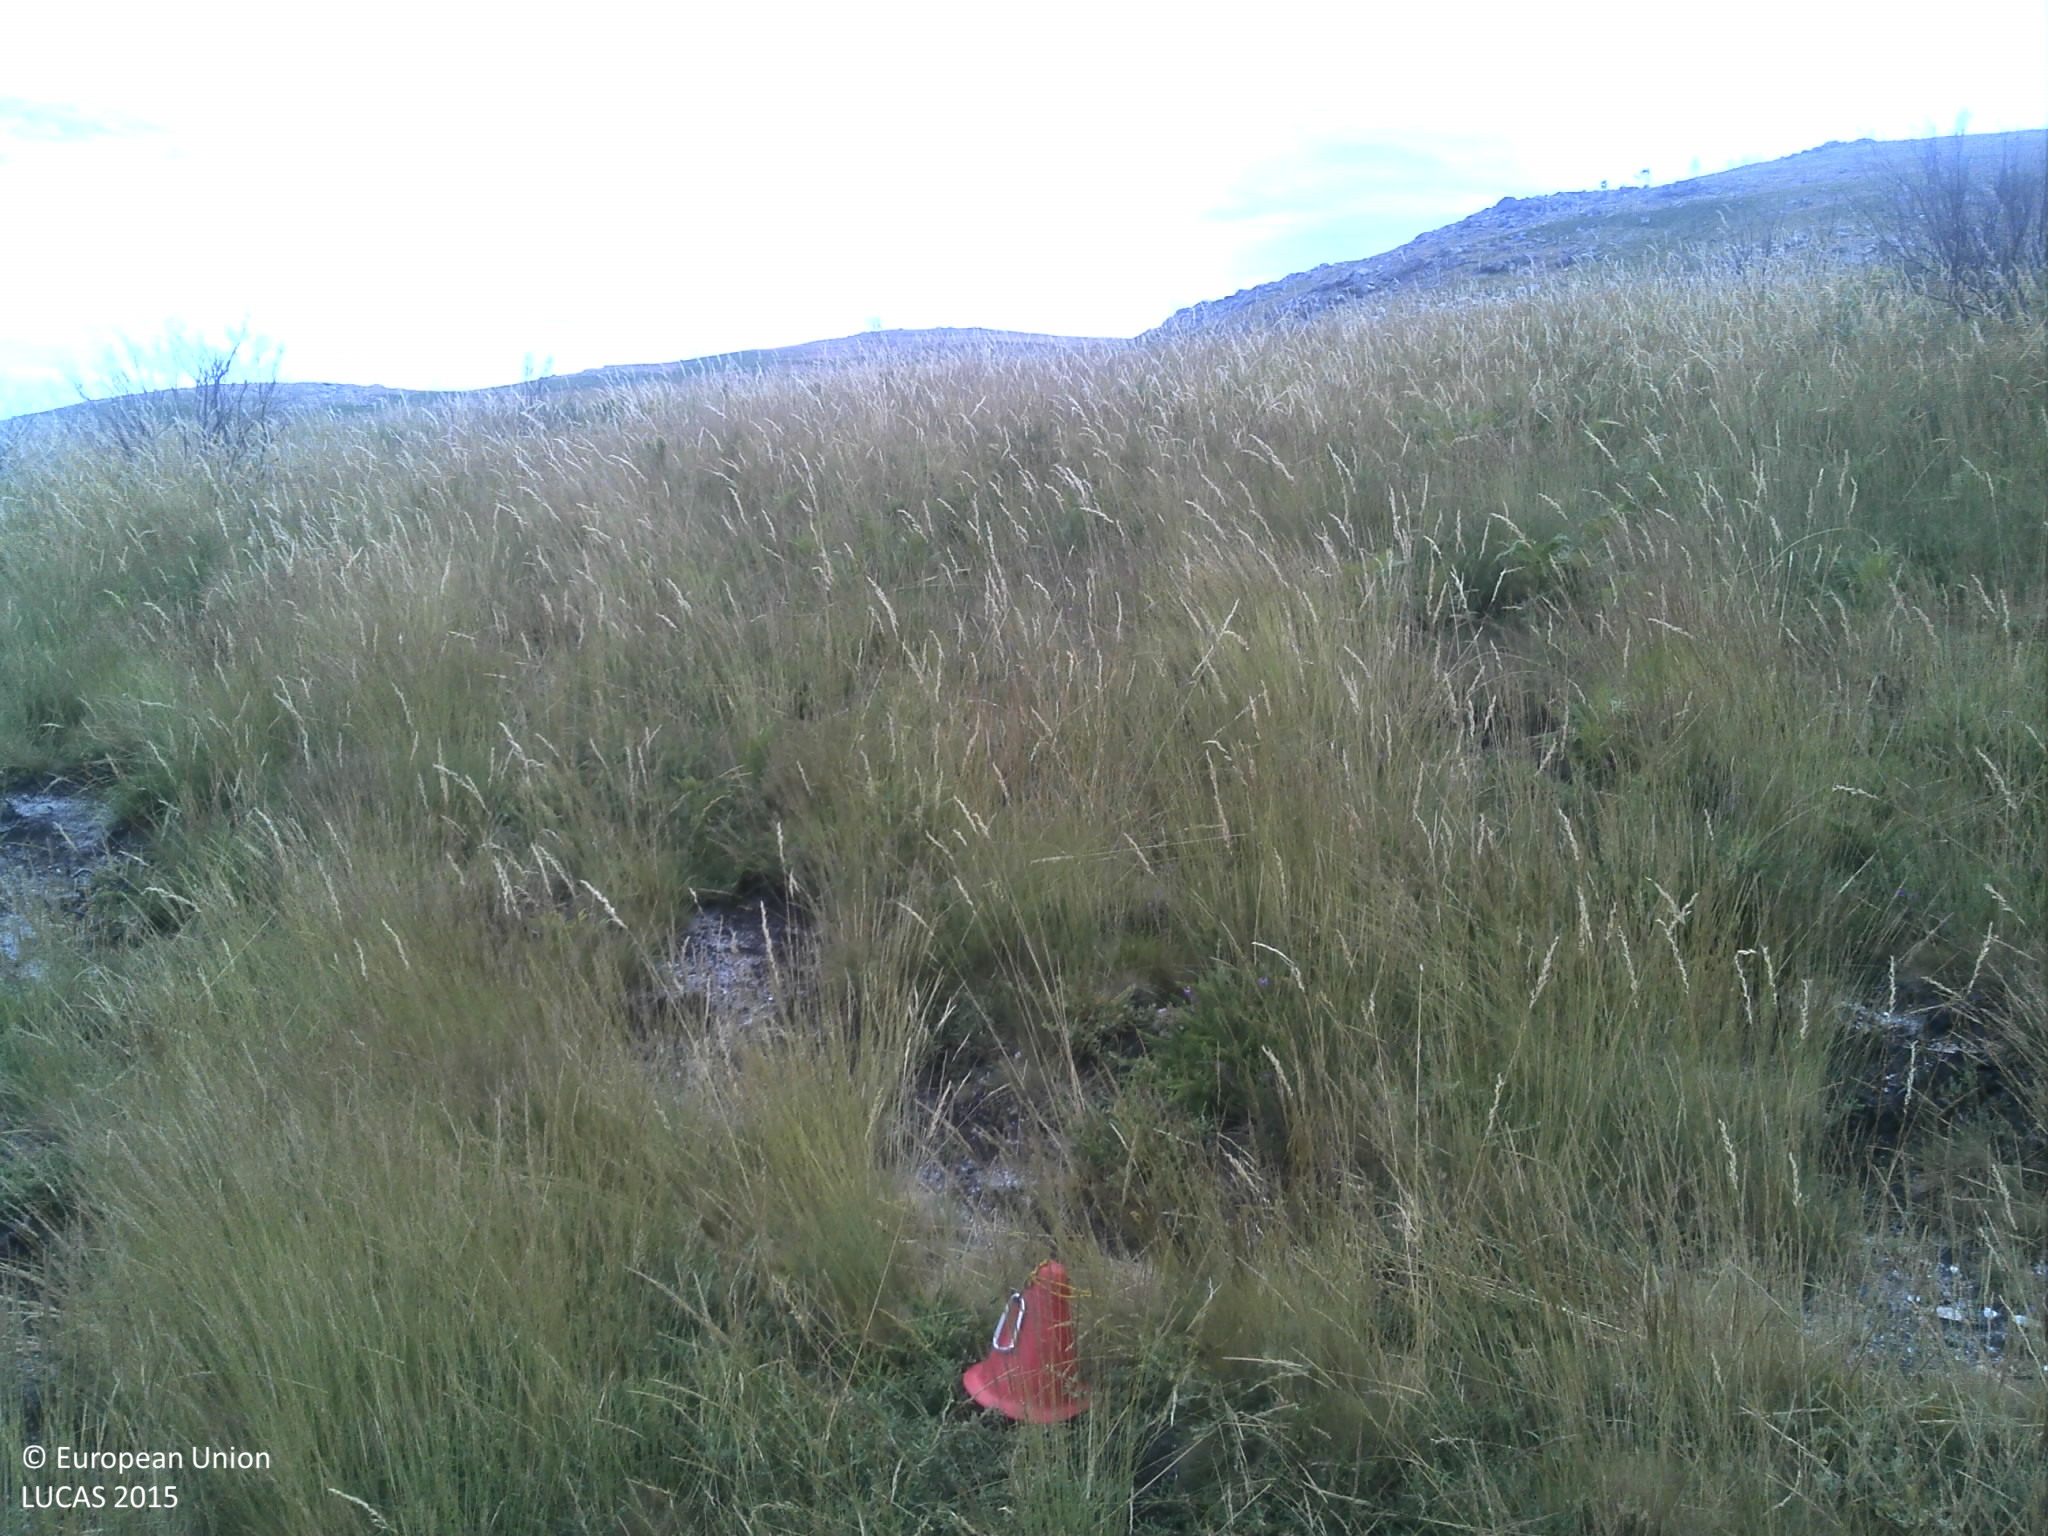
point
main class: Grassland
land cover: Grassland without tree/shrub cover
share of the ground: > 75 %
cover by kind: herbaceous plants 80 %, consolidated bare surface 10 %, shrubs 5 %, unconsolidated bare surface 5 %
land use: Agriculture (excluding fallow land and kitchen gardens)
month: July
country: PT
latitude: 41.3729
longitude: -7.8168
